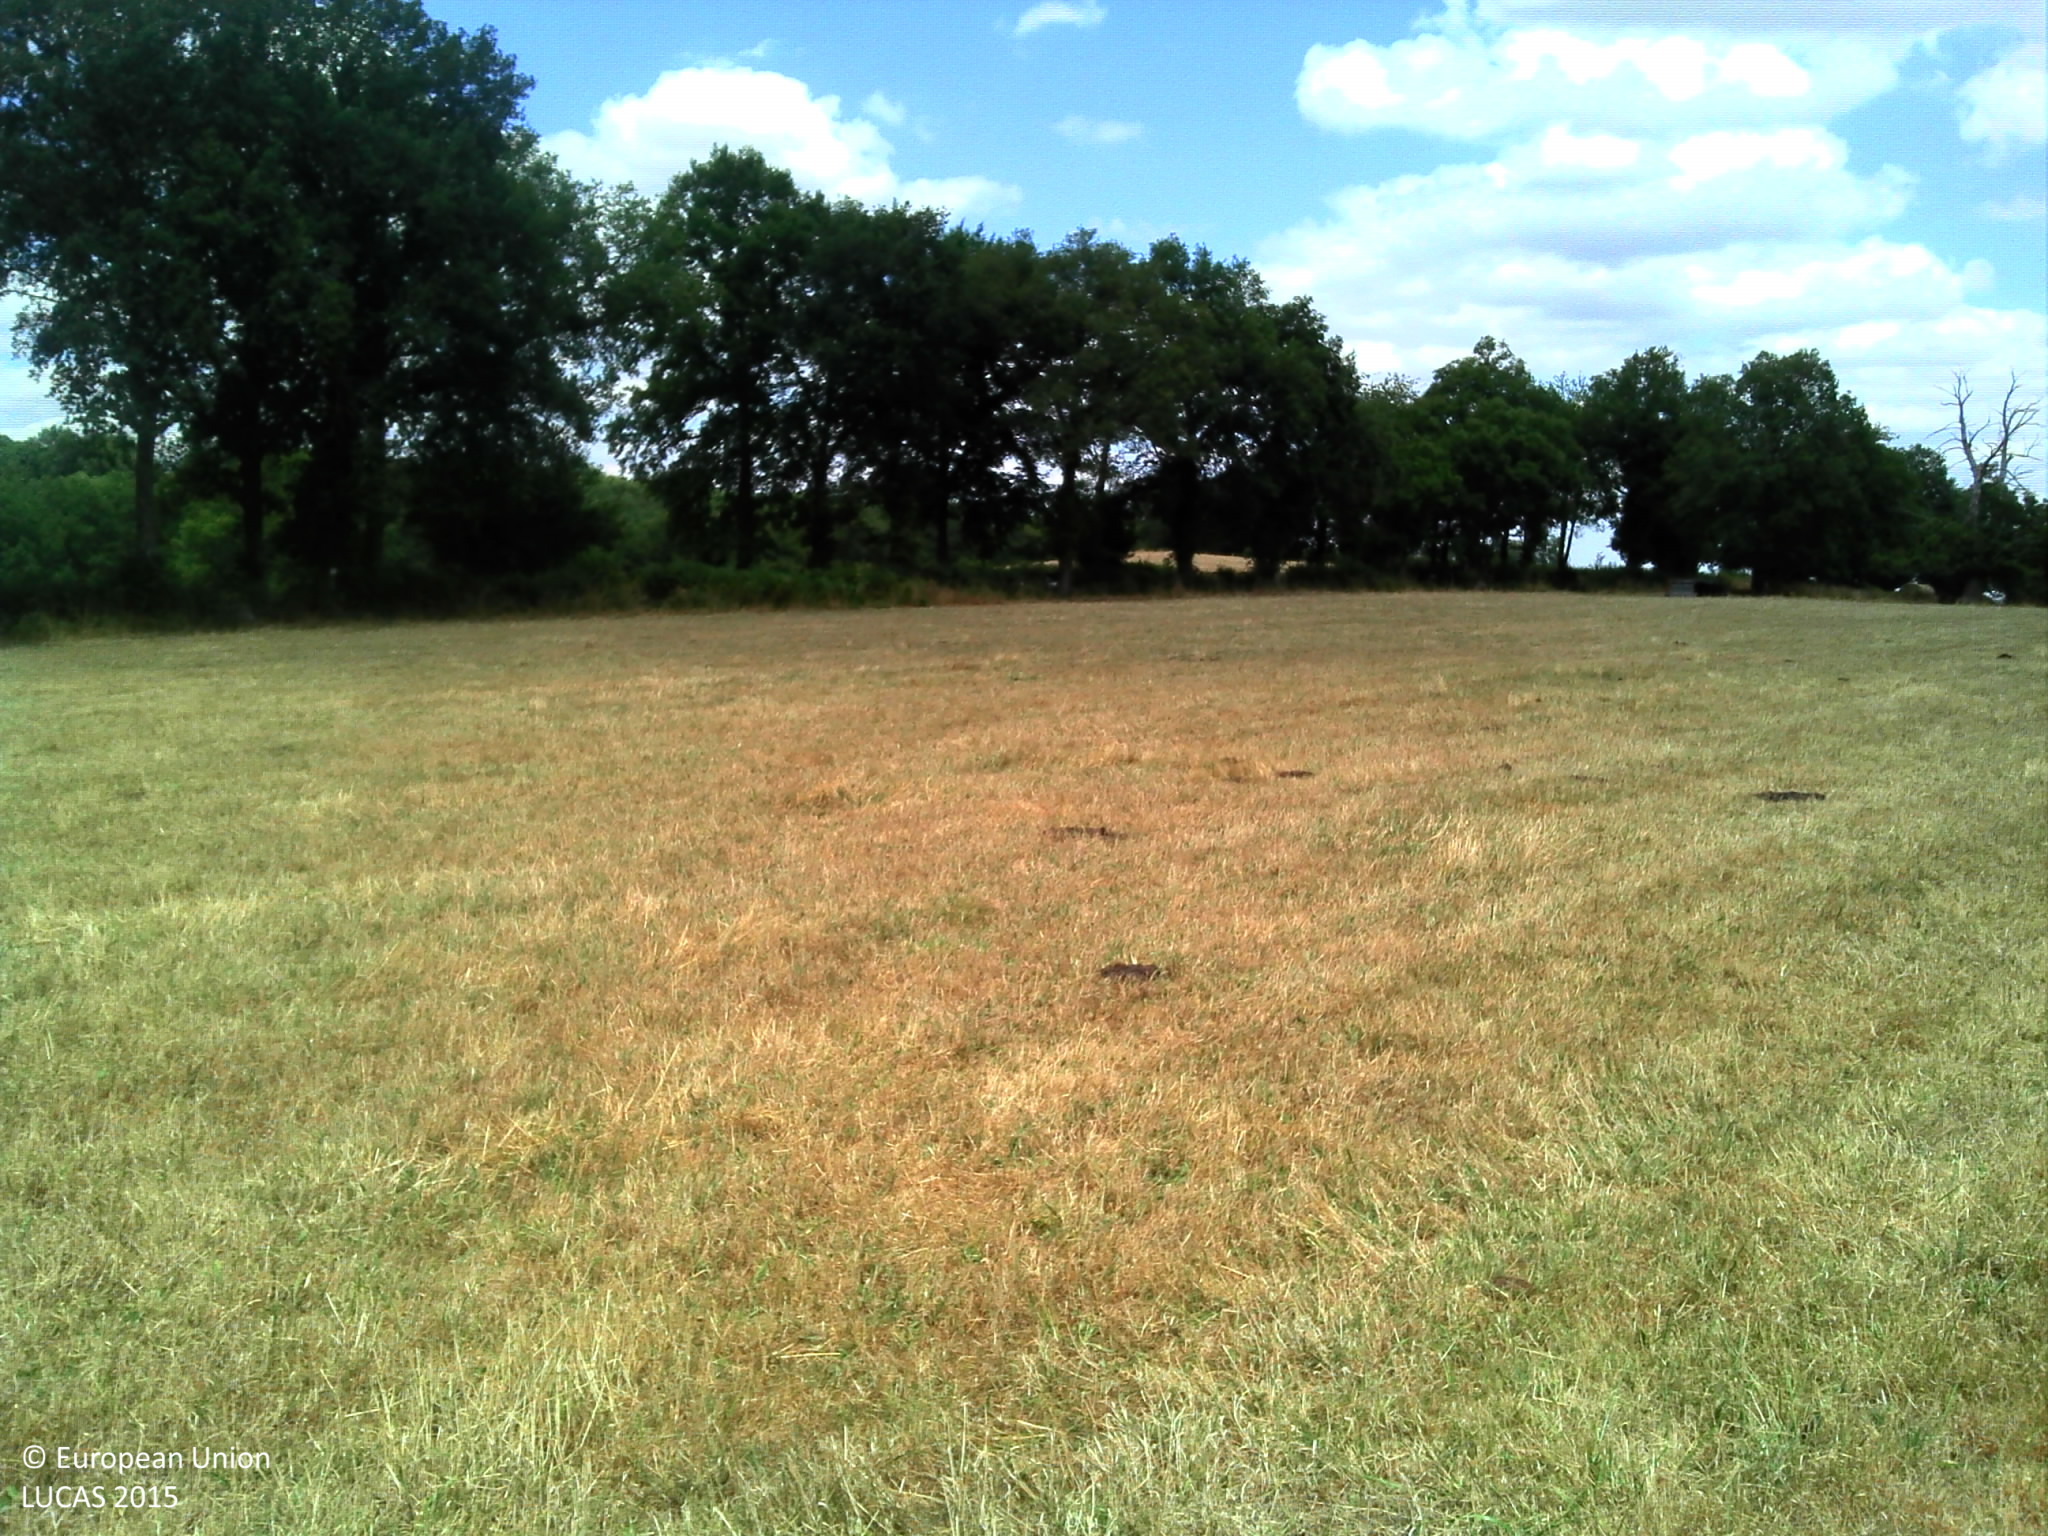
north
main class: Grassland
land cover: Grassland without tree/shrub cover
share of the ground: > 75 %
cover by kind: herbaceous plants 100 %
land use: Agriculture (excluding fallow land and kitchen gardens)
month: July
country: FR
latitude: 46.4297
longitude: 2.2249
